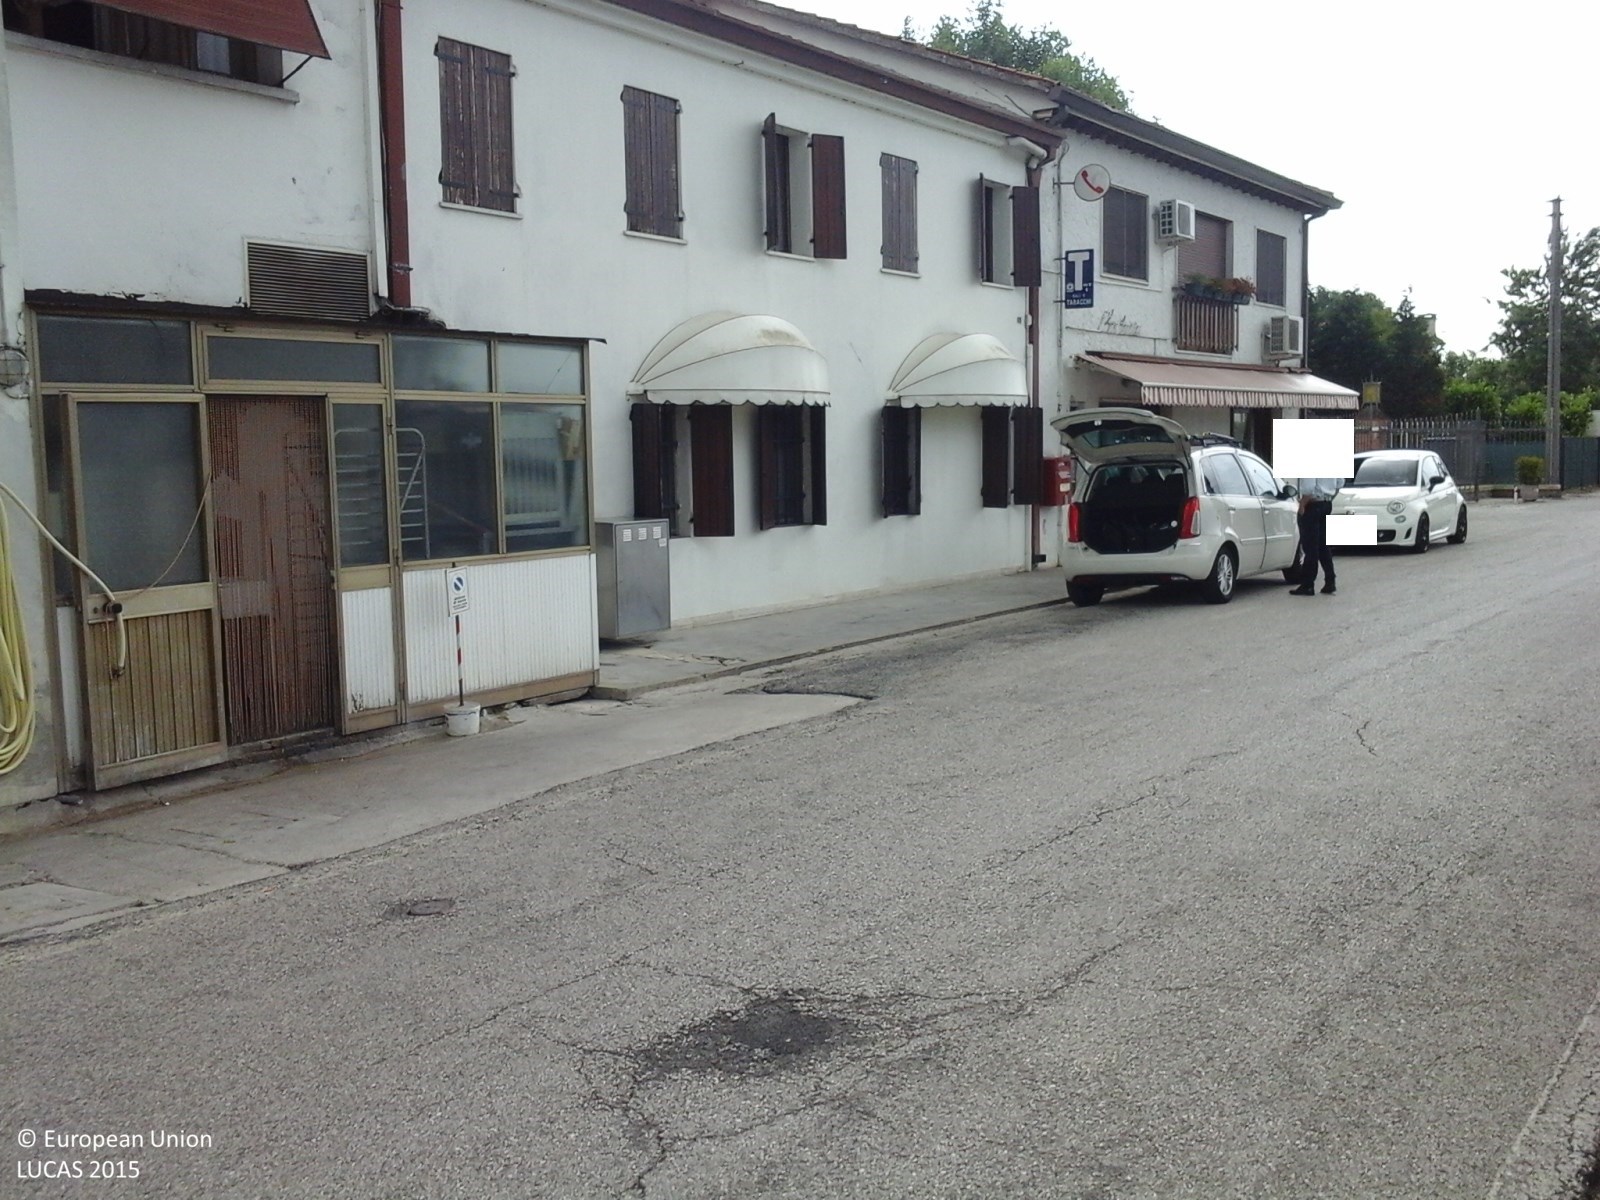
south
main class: Cropland
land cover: Potatoes
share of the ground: > 75 %
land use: Agriculture (excluding fallow land and kitchen gardens)
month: June
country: IT
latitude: 45.6719
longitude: 12.5509
